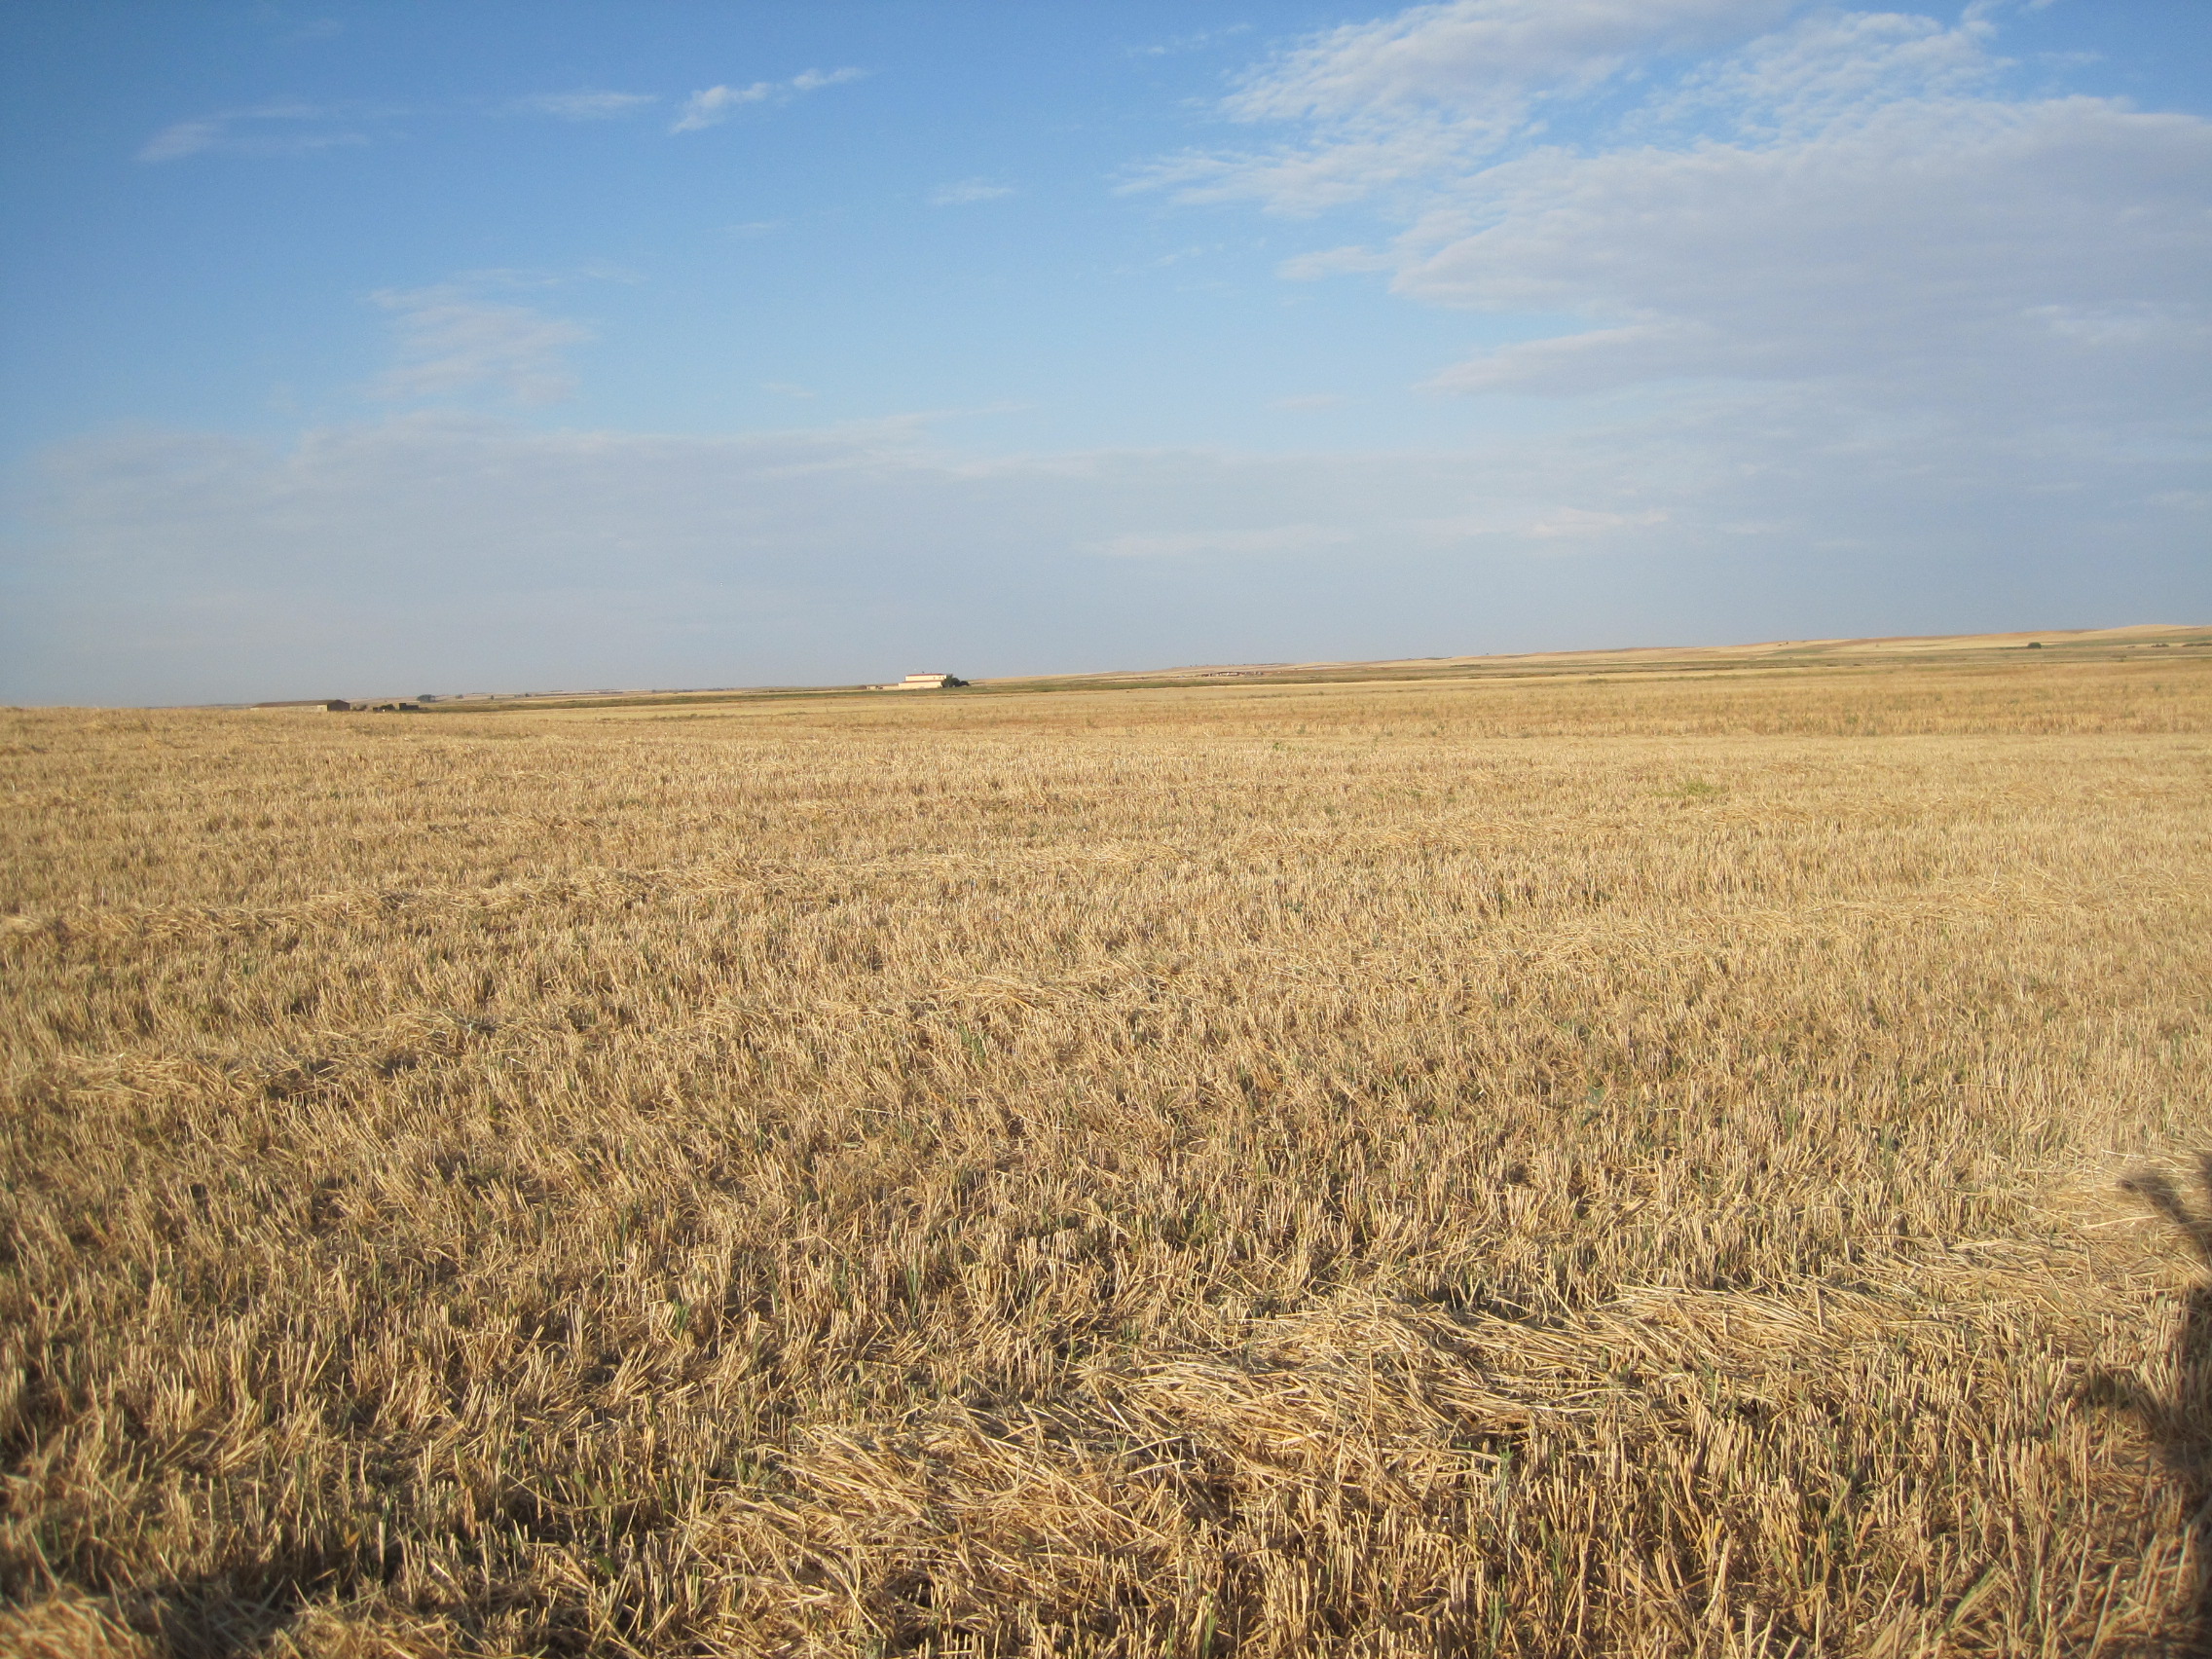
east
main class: Cropland
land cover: Barley
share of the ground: < 10 %
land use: Agriculture (excluding fallow land and kitchen gardens)
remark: Harvested field
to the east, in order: Barley; Rape and turnip rape
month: July
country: ES
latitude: 41.8389
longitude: -5.6110
